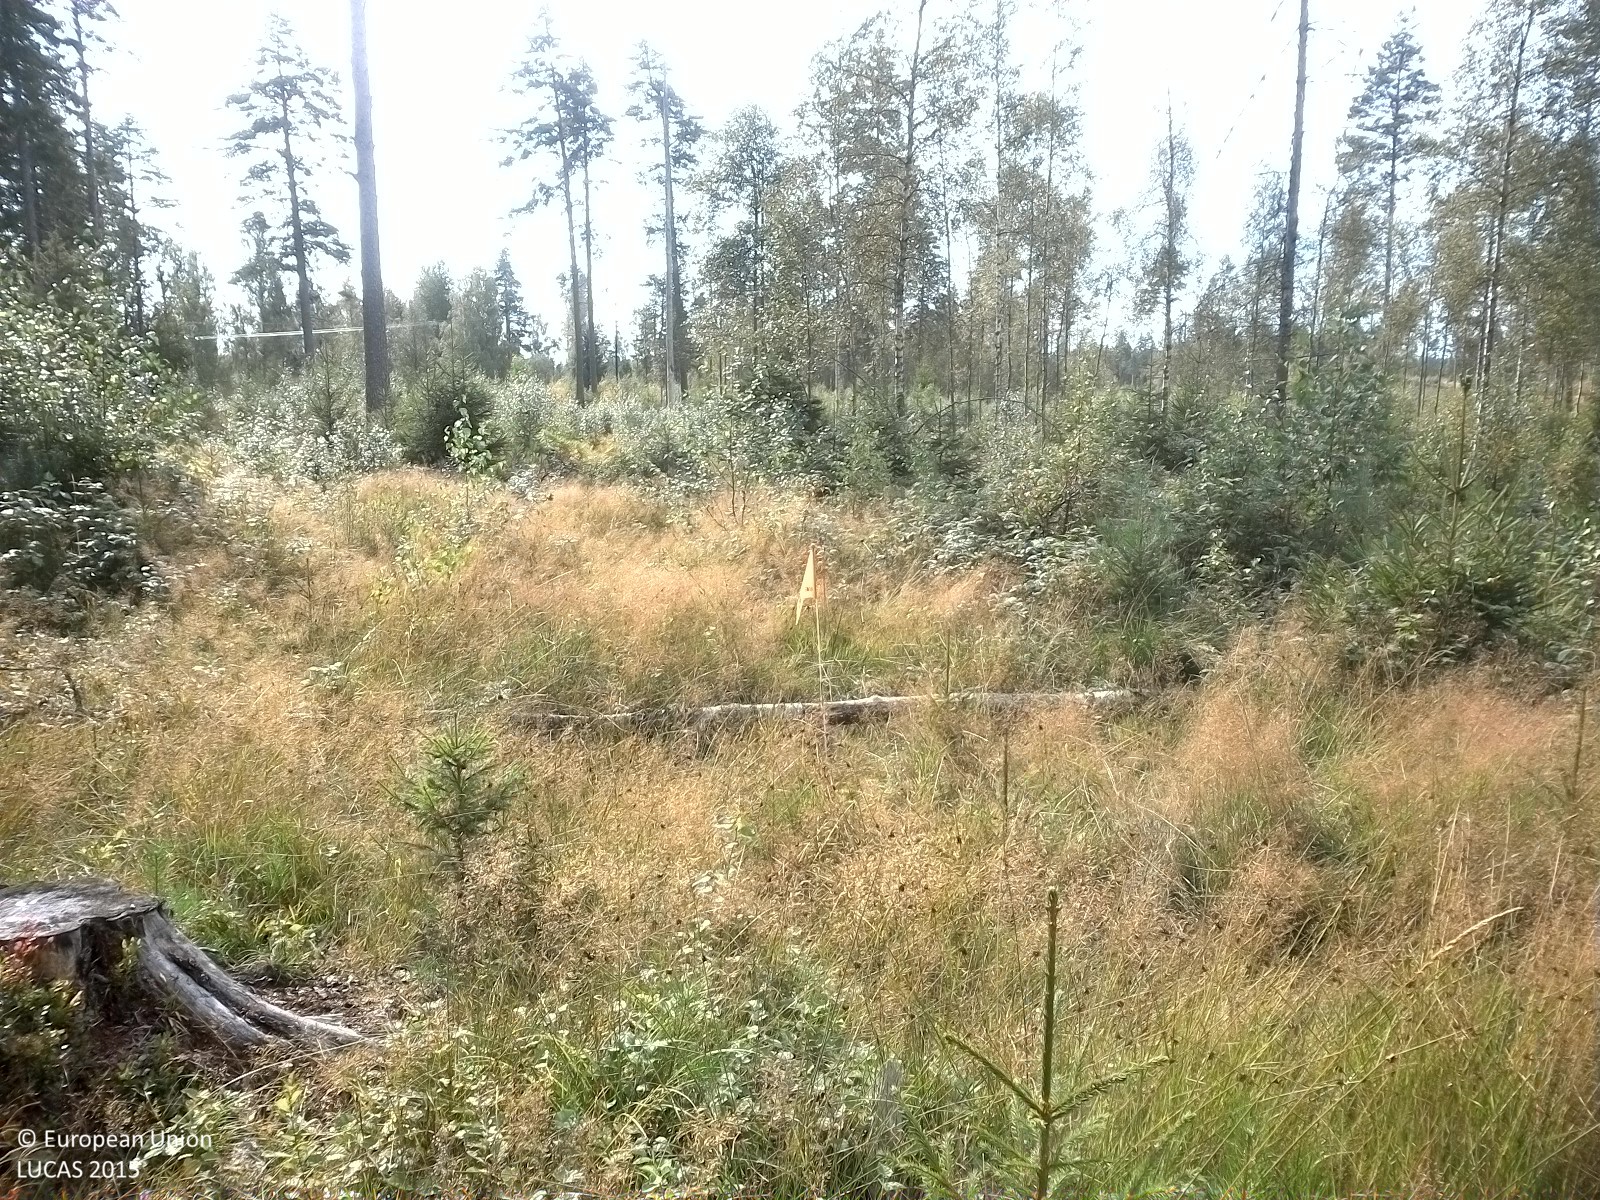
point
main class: Woodland
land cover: Spruce dominated mixed woodland
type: boreal forest
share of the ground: 25 - 50 %
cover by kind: herbaceous plants 45 %, coniferous forest trees 20 %, broadleaved forest trees 15 %, shrubs 10 %, lichens and mosses 10 %
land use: Forestry
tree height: < 5 m
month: August
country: SE
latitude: 58.8456
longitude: 15.5214
